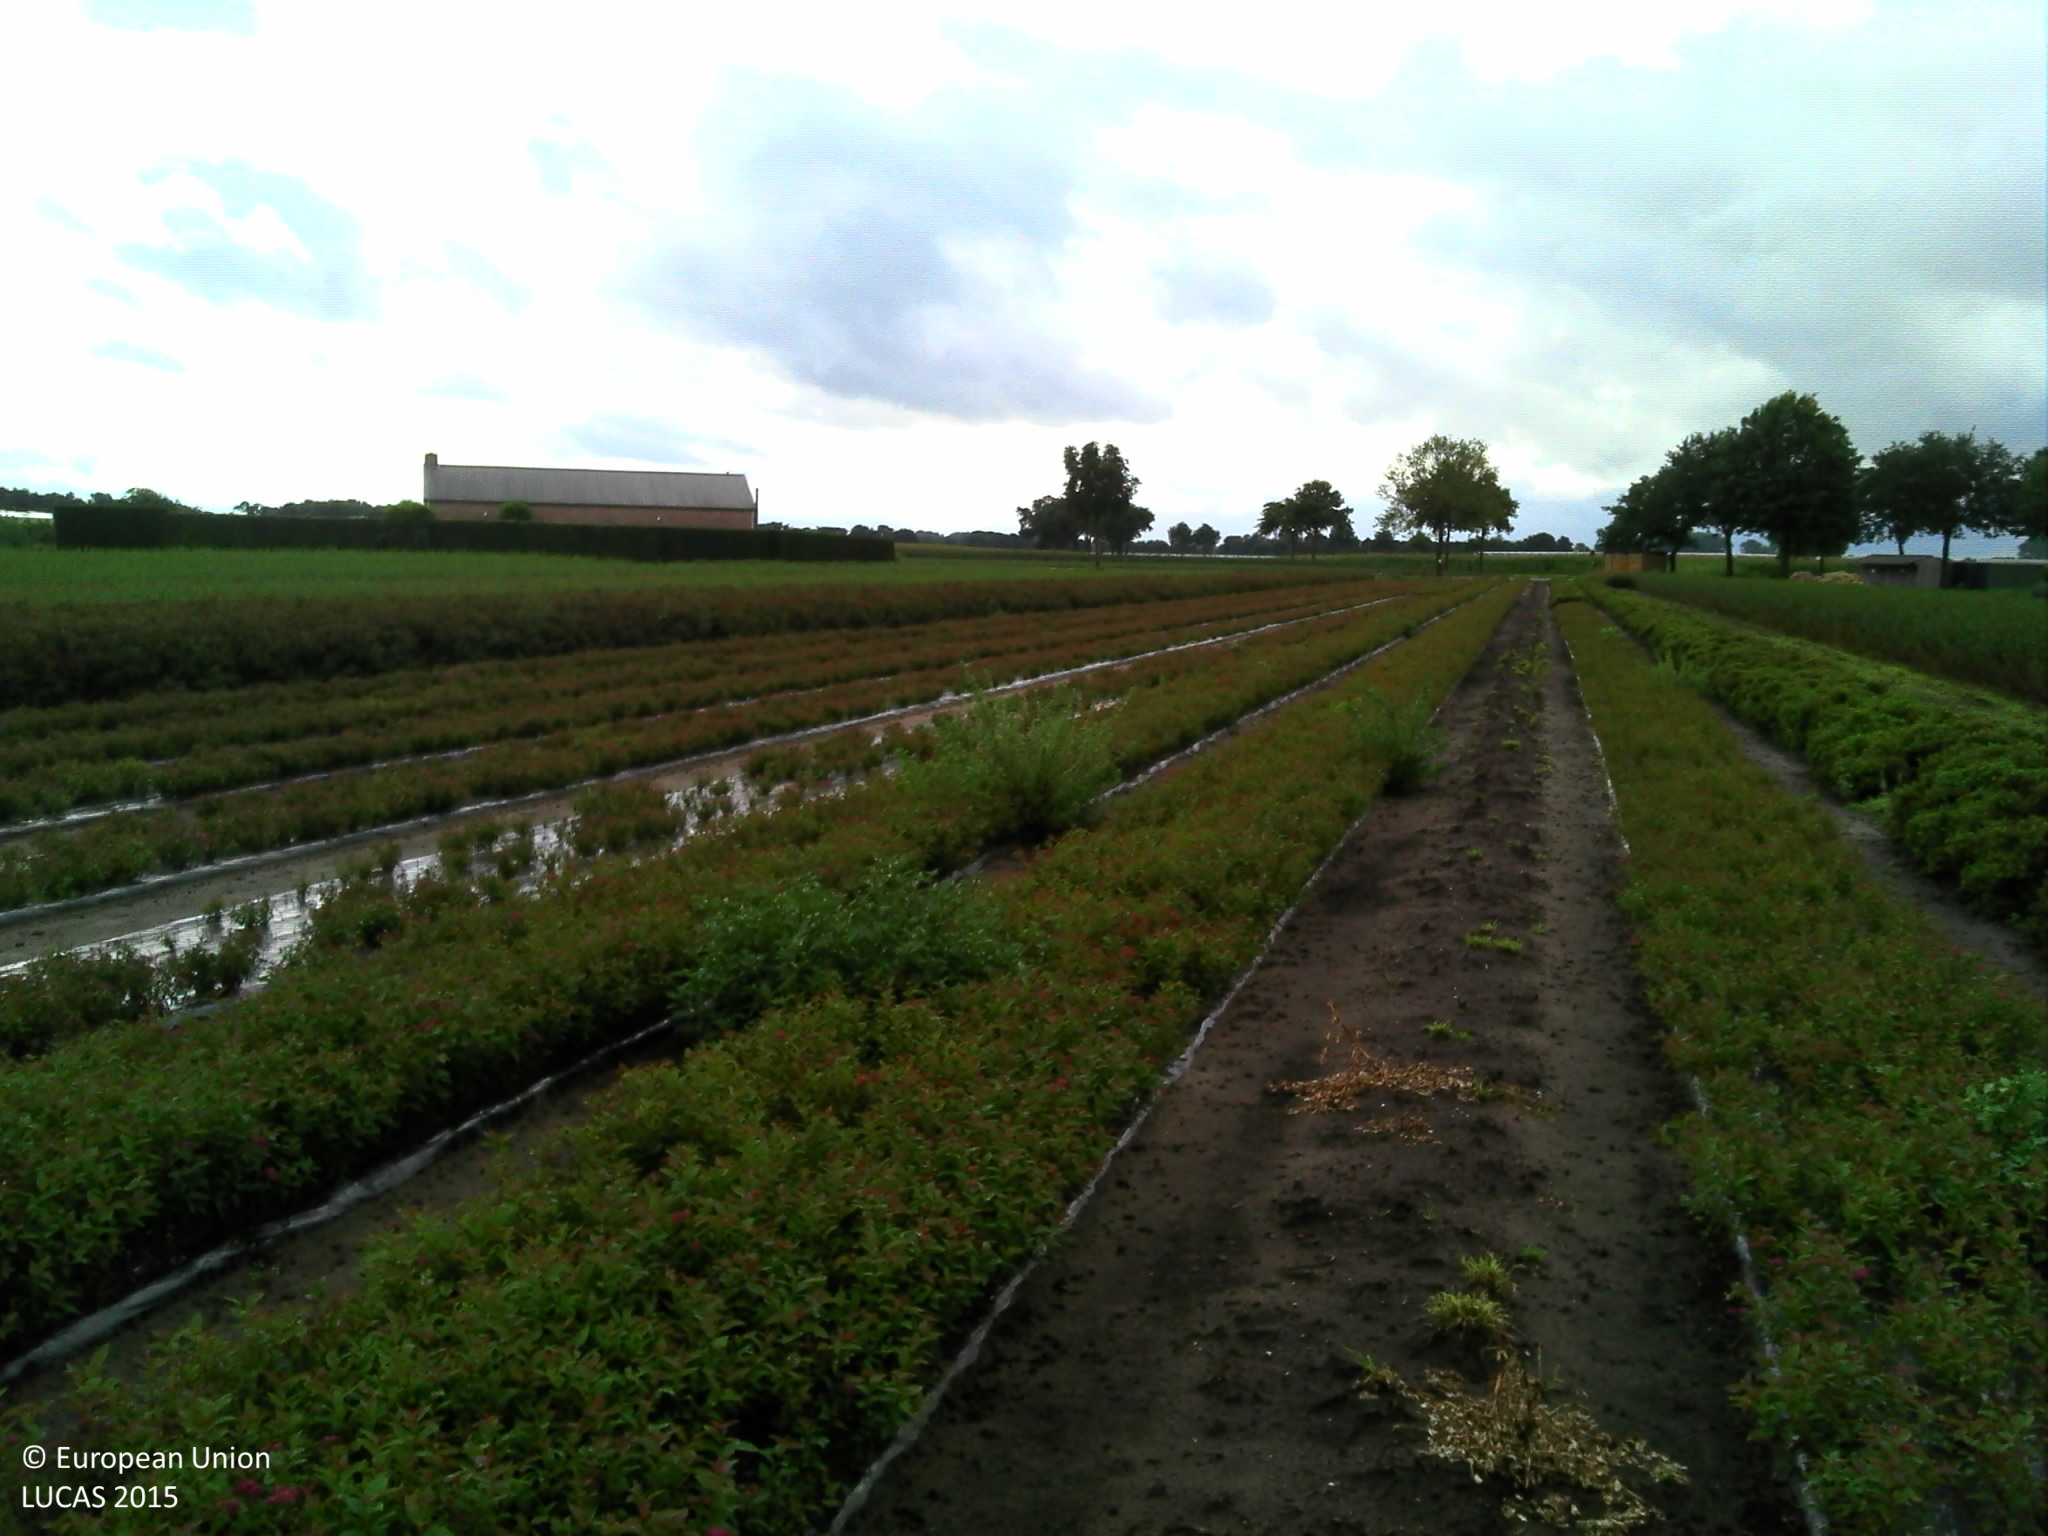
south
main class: Cropland
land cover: Nurseries
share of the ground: 50 - 75 %
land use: Agriculture (excluding fallow land and kitchen gardens)
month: September
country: BE
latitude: 51.4517
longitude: 4.7729
